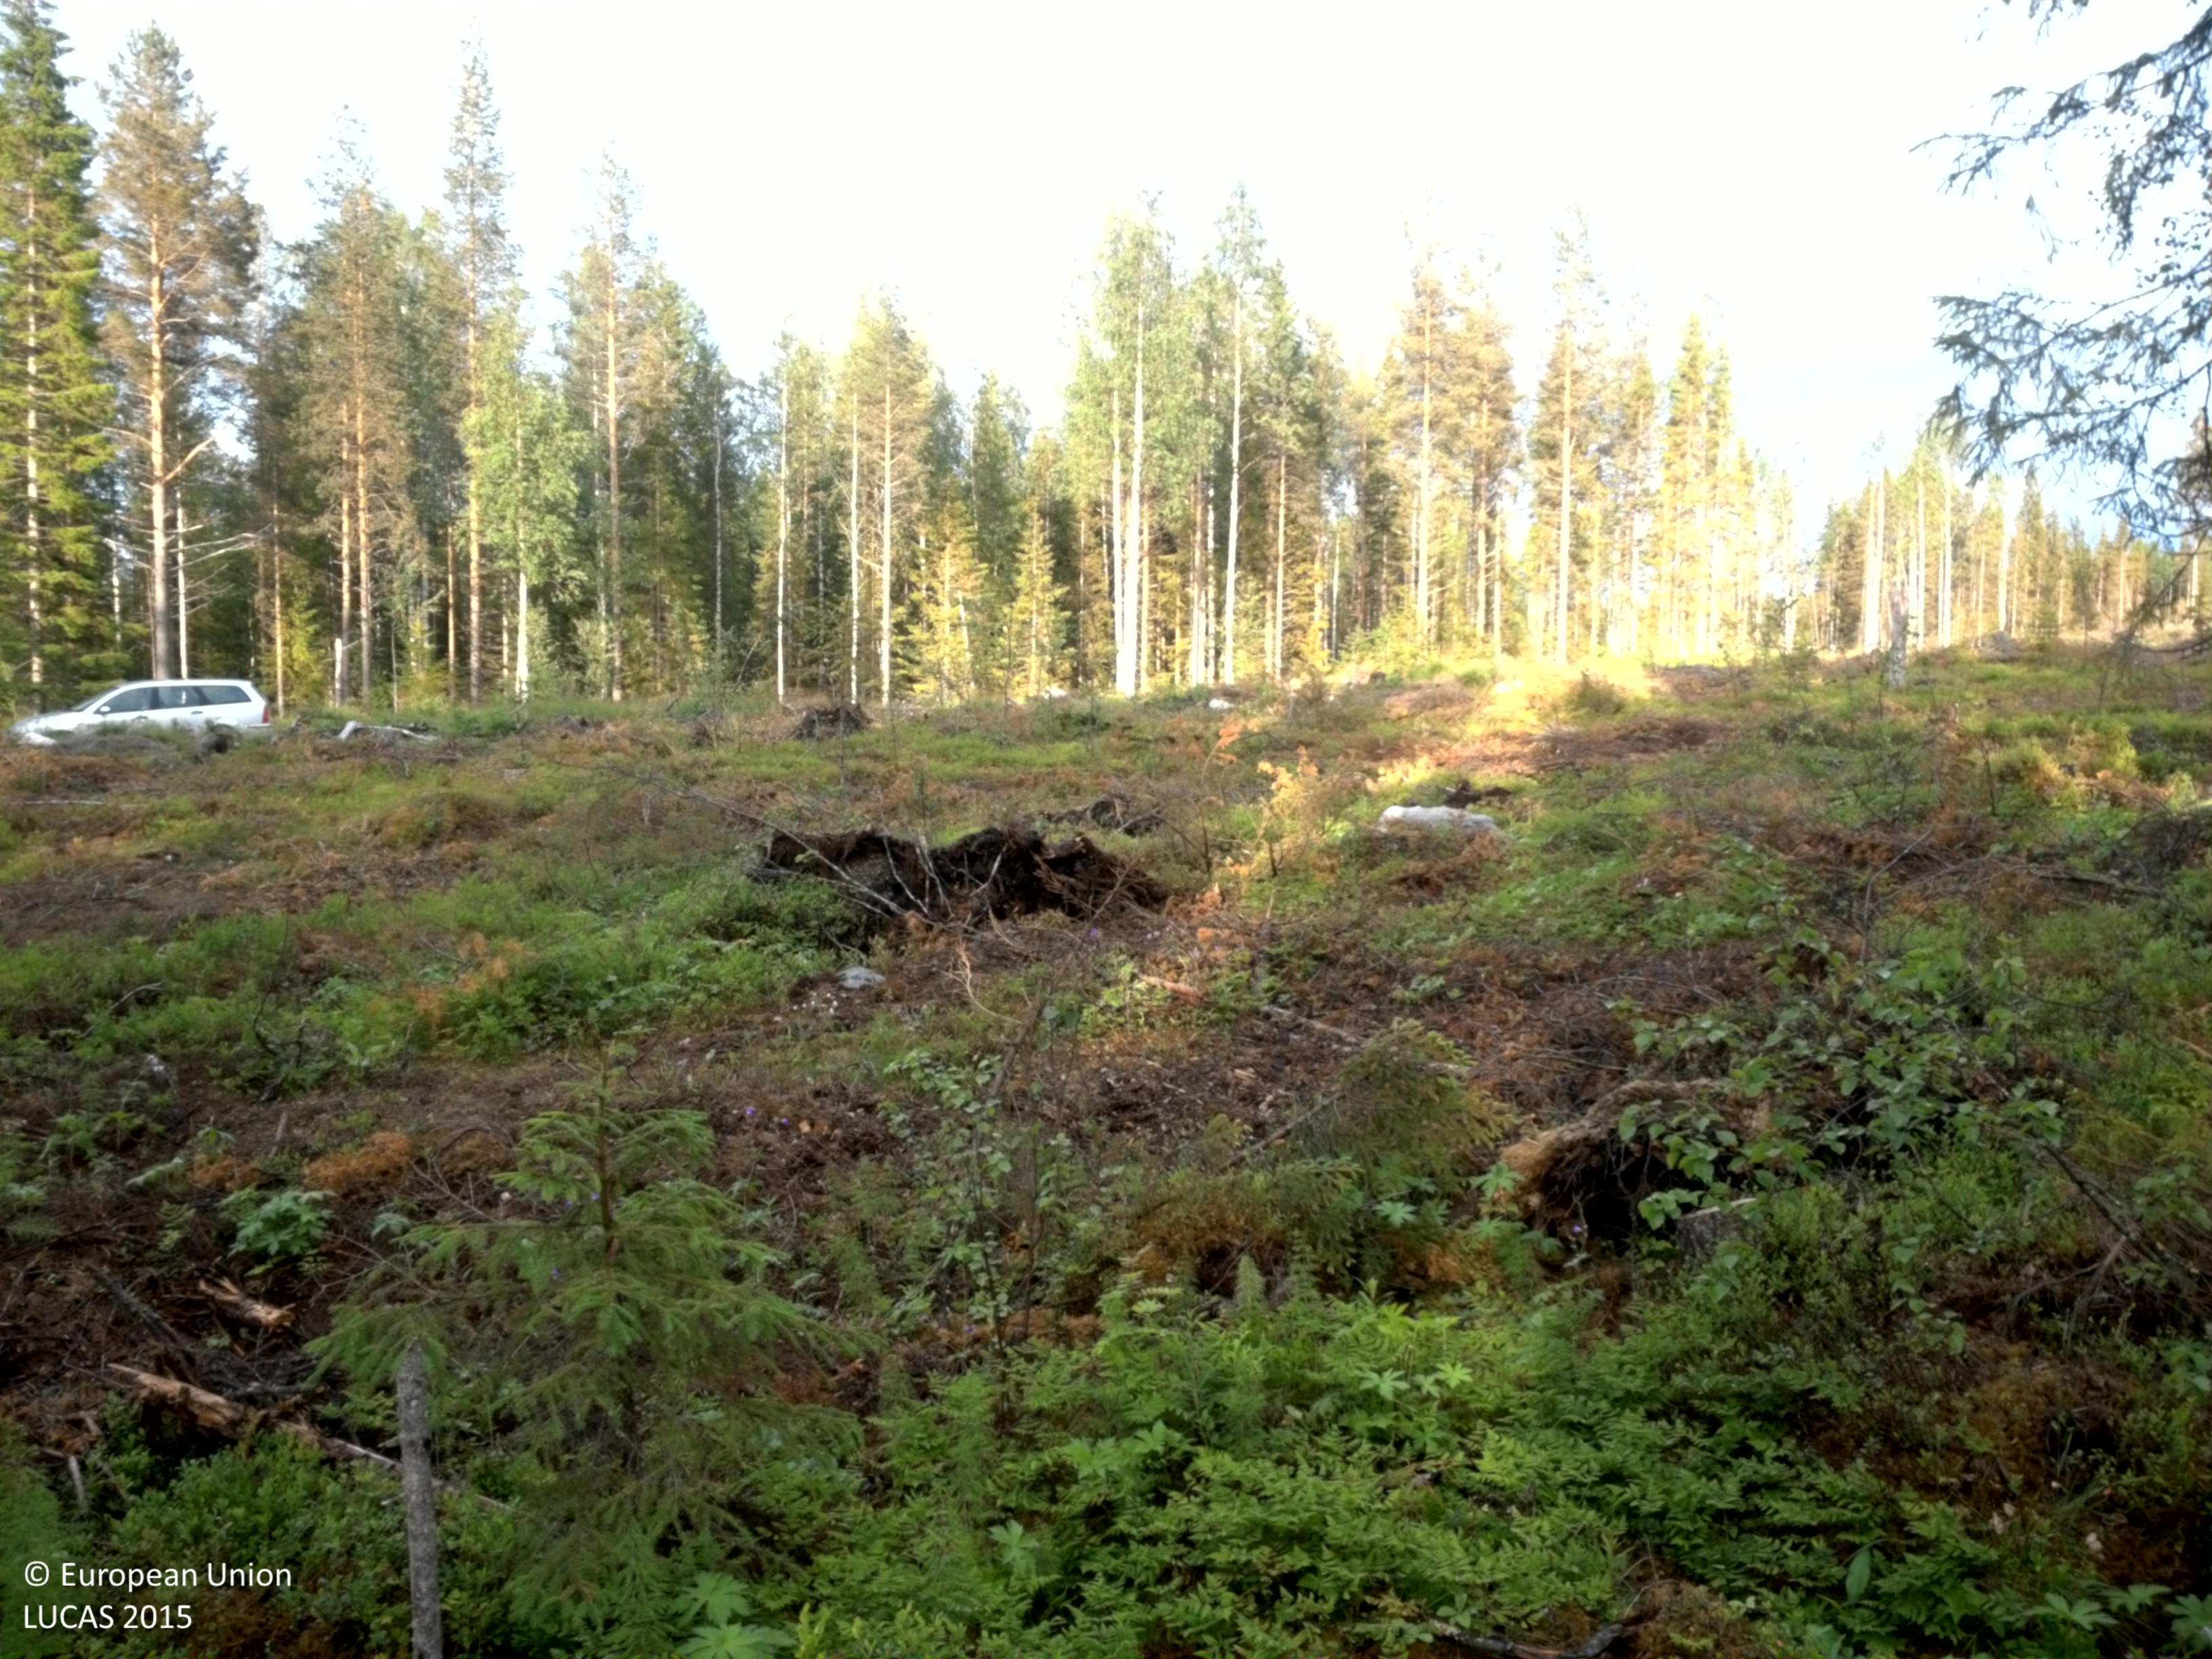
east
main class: Woodland
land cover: Pine dominated coniferous woodland
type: boreal forest
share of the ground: 25 - 50 %
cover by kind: coniferous forest trees 40 %, shrubs 40 %, broadleaved forest trees 10 %, herbaceous plants 10 %
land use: Forestry
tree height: > 5 m
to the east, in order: Pine dominated coniferous woodland; Shrubland with sparse tree cover; Grassland without tree/shrub cover; Ditches and canals; Paved roads, cycling and walking lanes; Ditches and canals; Grassland without tree/shrub cover; Shrubland with sparse tree cover; Pine dominated mixed woodland; Spruce dominated mixed woodland; Ponds and wetlands; Spruce dominated mixed woodland; Spruce dominated coniferous woodland; Ditches and canals; Spruce dominated coniferous woodland; Tracks; Spruce dominated mixed woodland
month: July
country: SE
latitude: 64.6458
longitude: 18.4437
